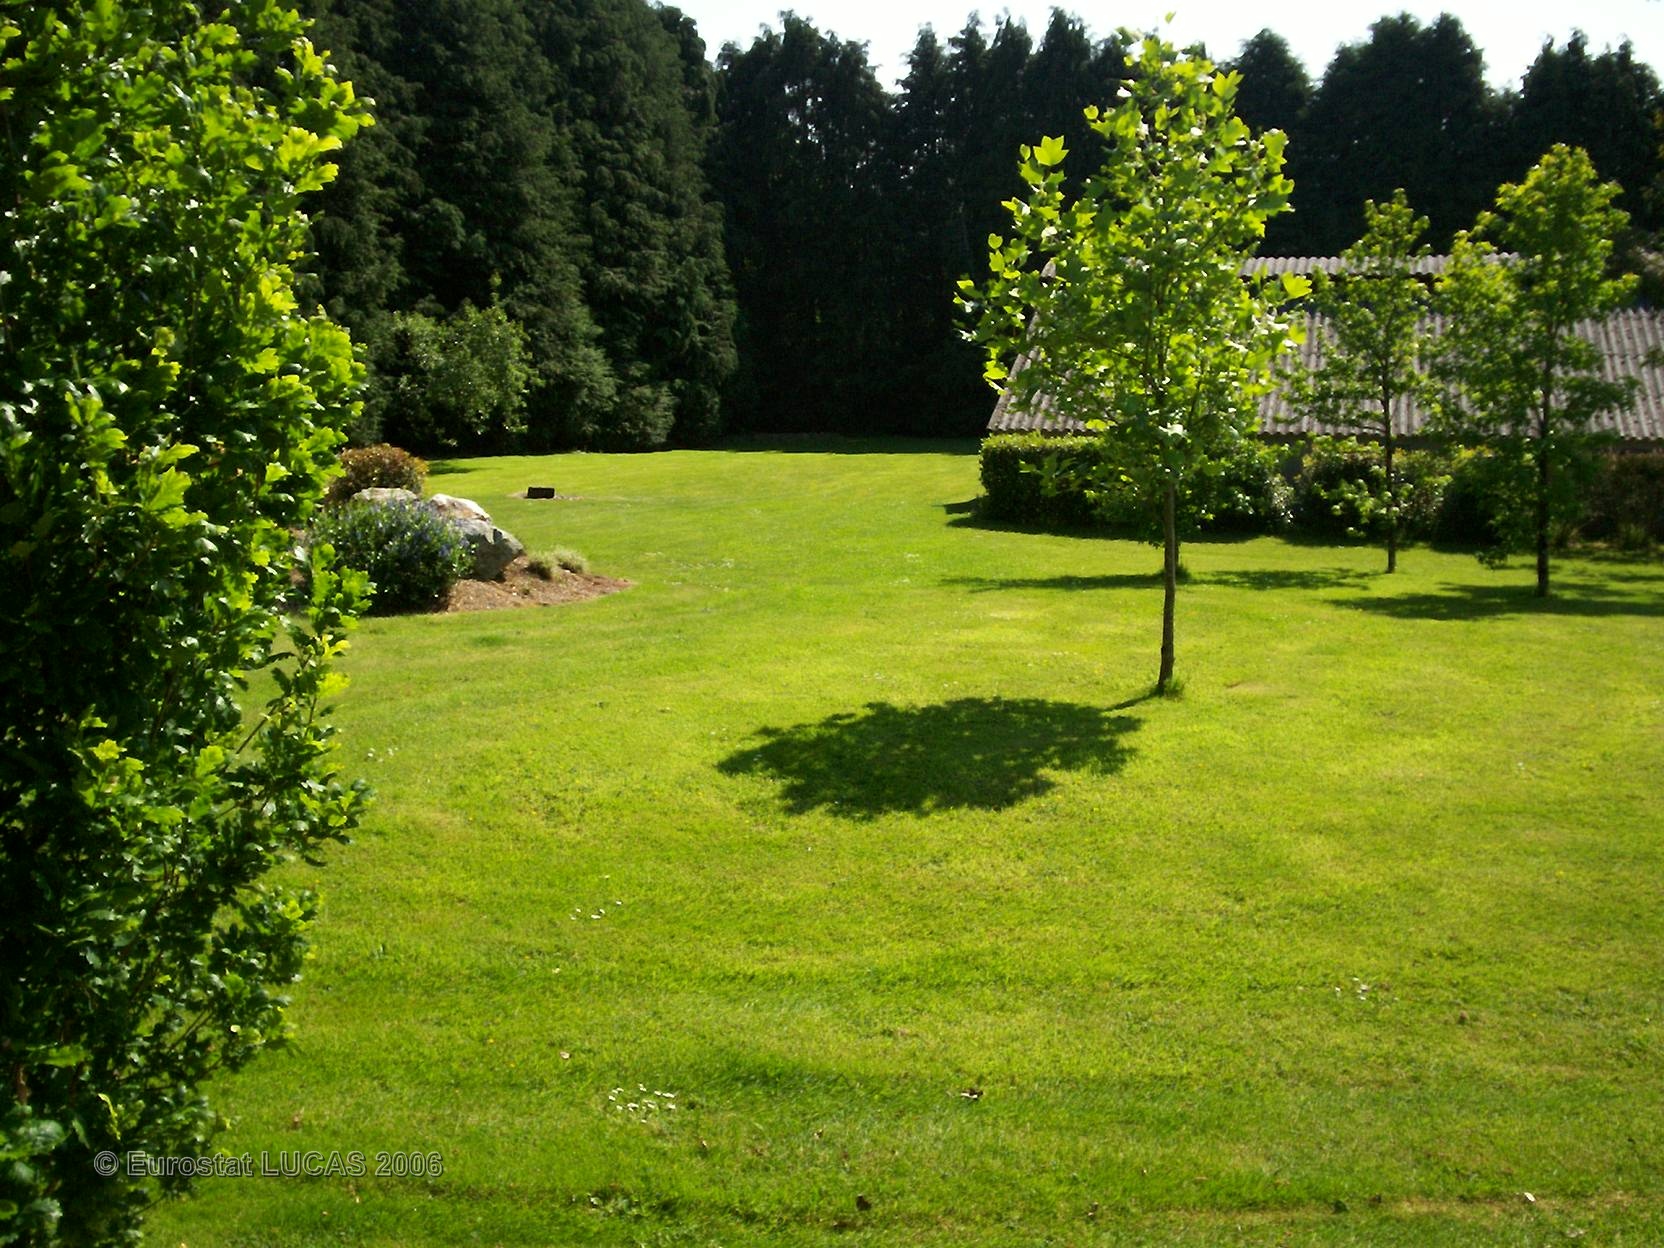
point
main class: Grassland
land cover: Grassland with sparse tree/shrub cover
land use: Residential
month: June
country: FR
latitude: 48.4229
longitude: -3.6900
